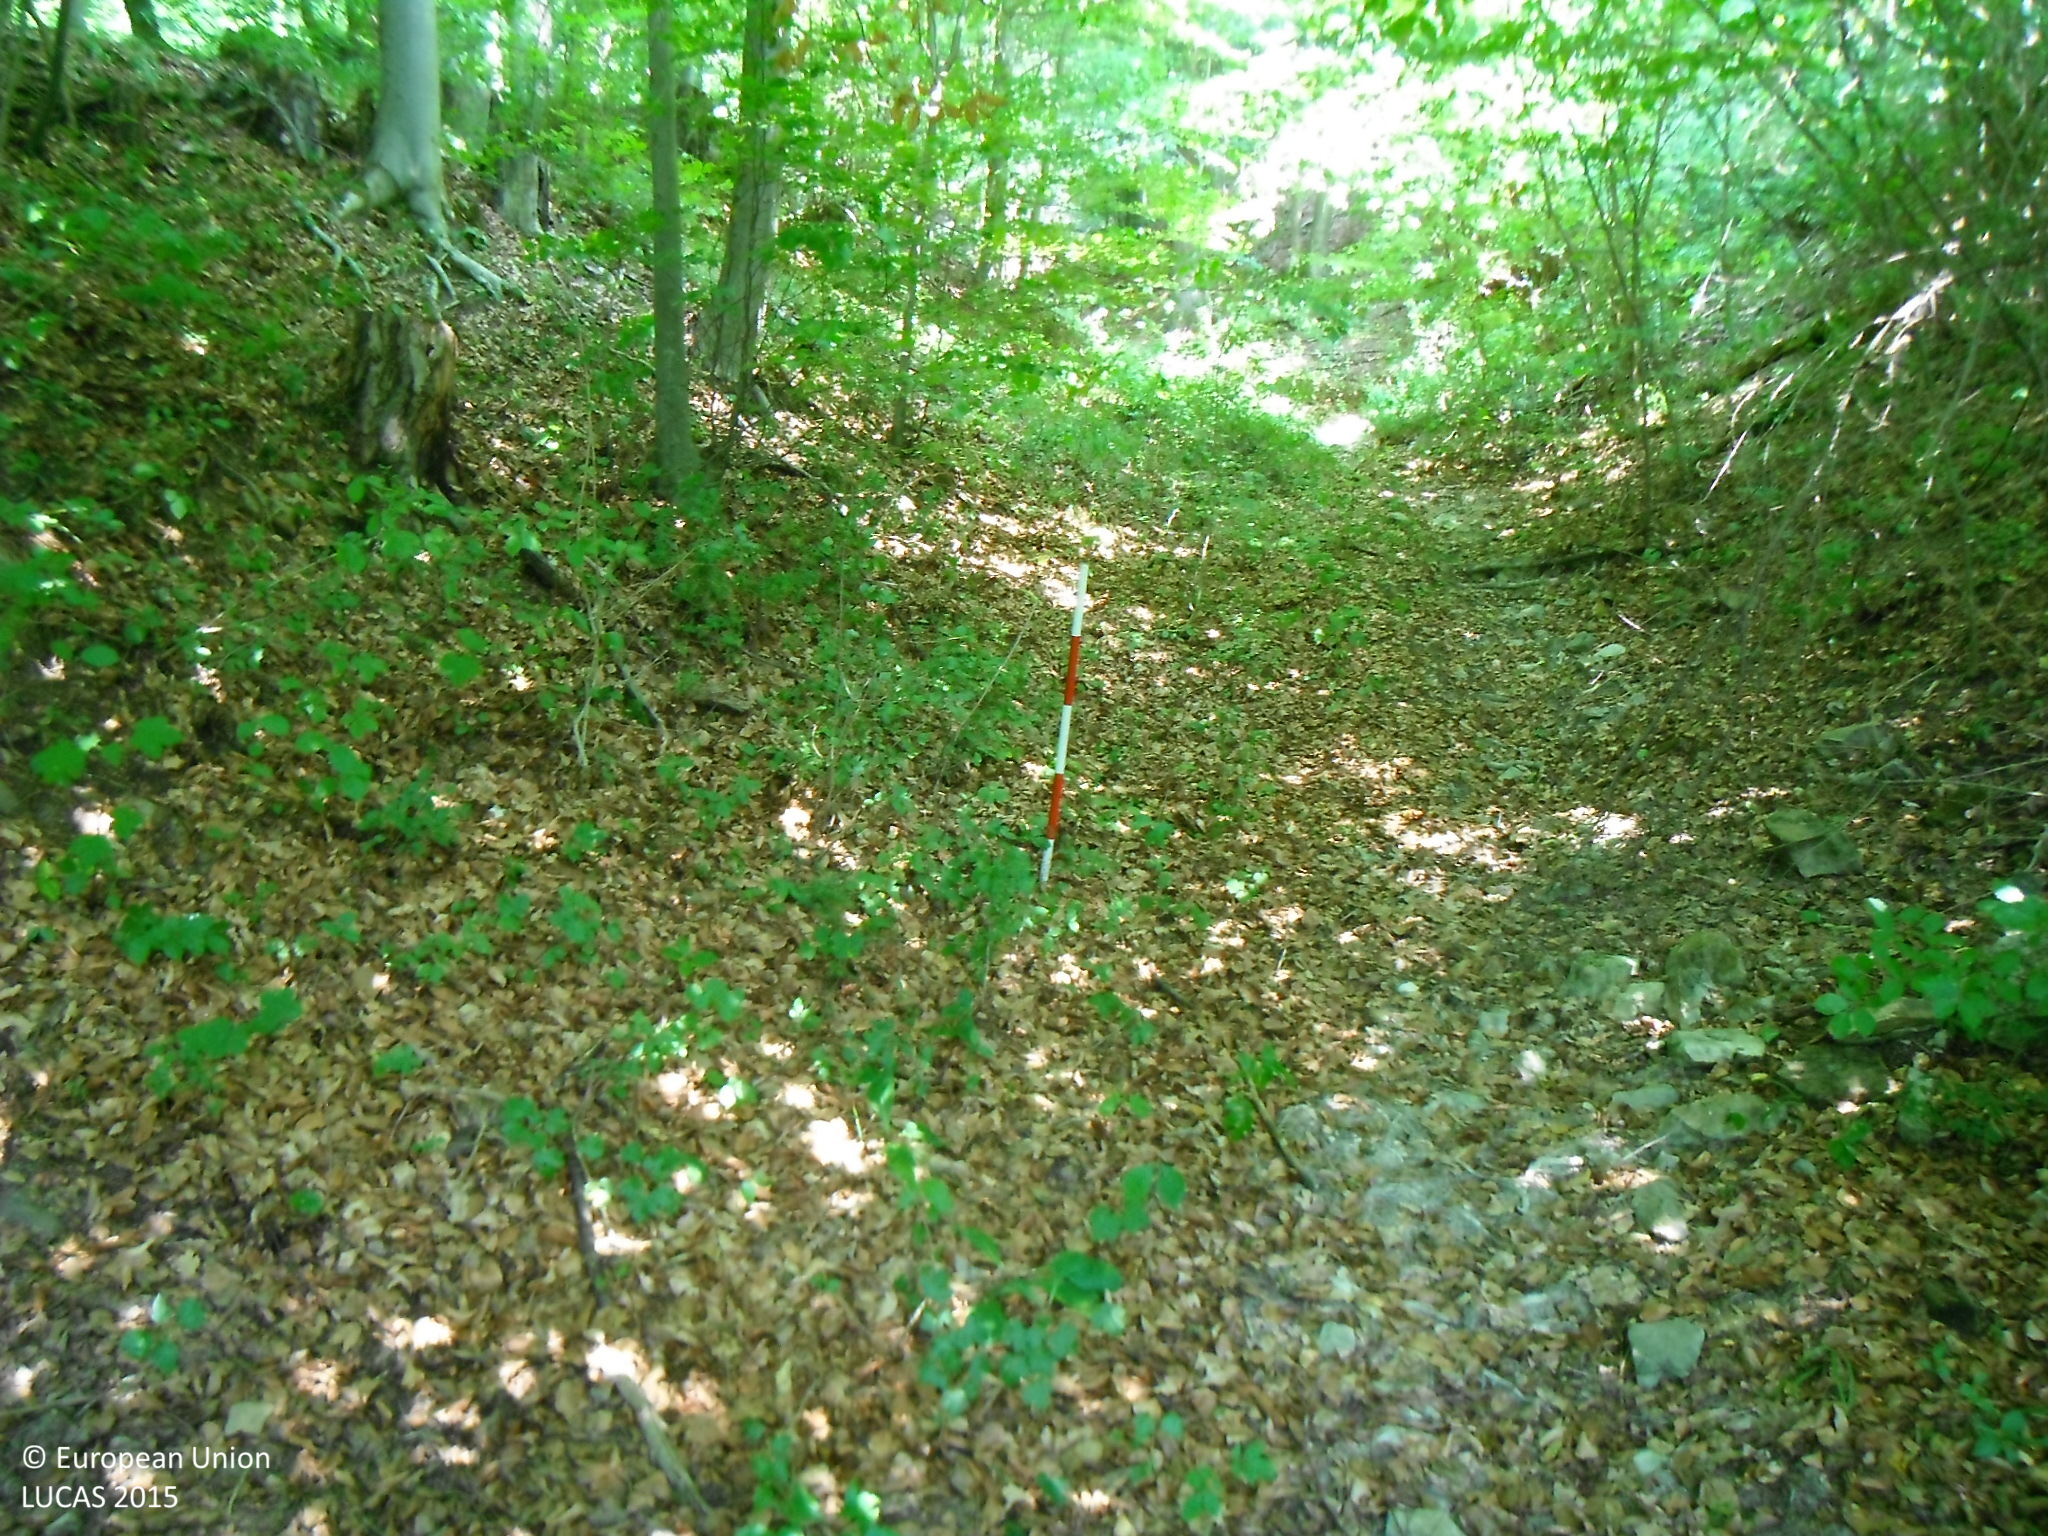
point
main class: Woodland
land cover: Pine dominated mixed woodland
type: mesophytic deciduous forest
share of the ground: > 75 %
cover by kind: broadleaved forest trees 65 %, coniferous forest trees 25 %, shrubs 10 %
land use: Forestry
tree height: > 5 m
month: August
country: SK
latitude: 48.9526
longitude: 18.3880
